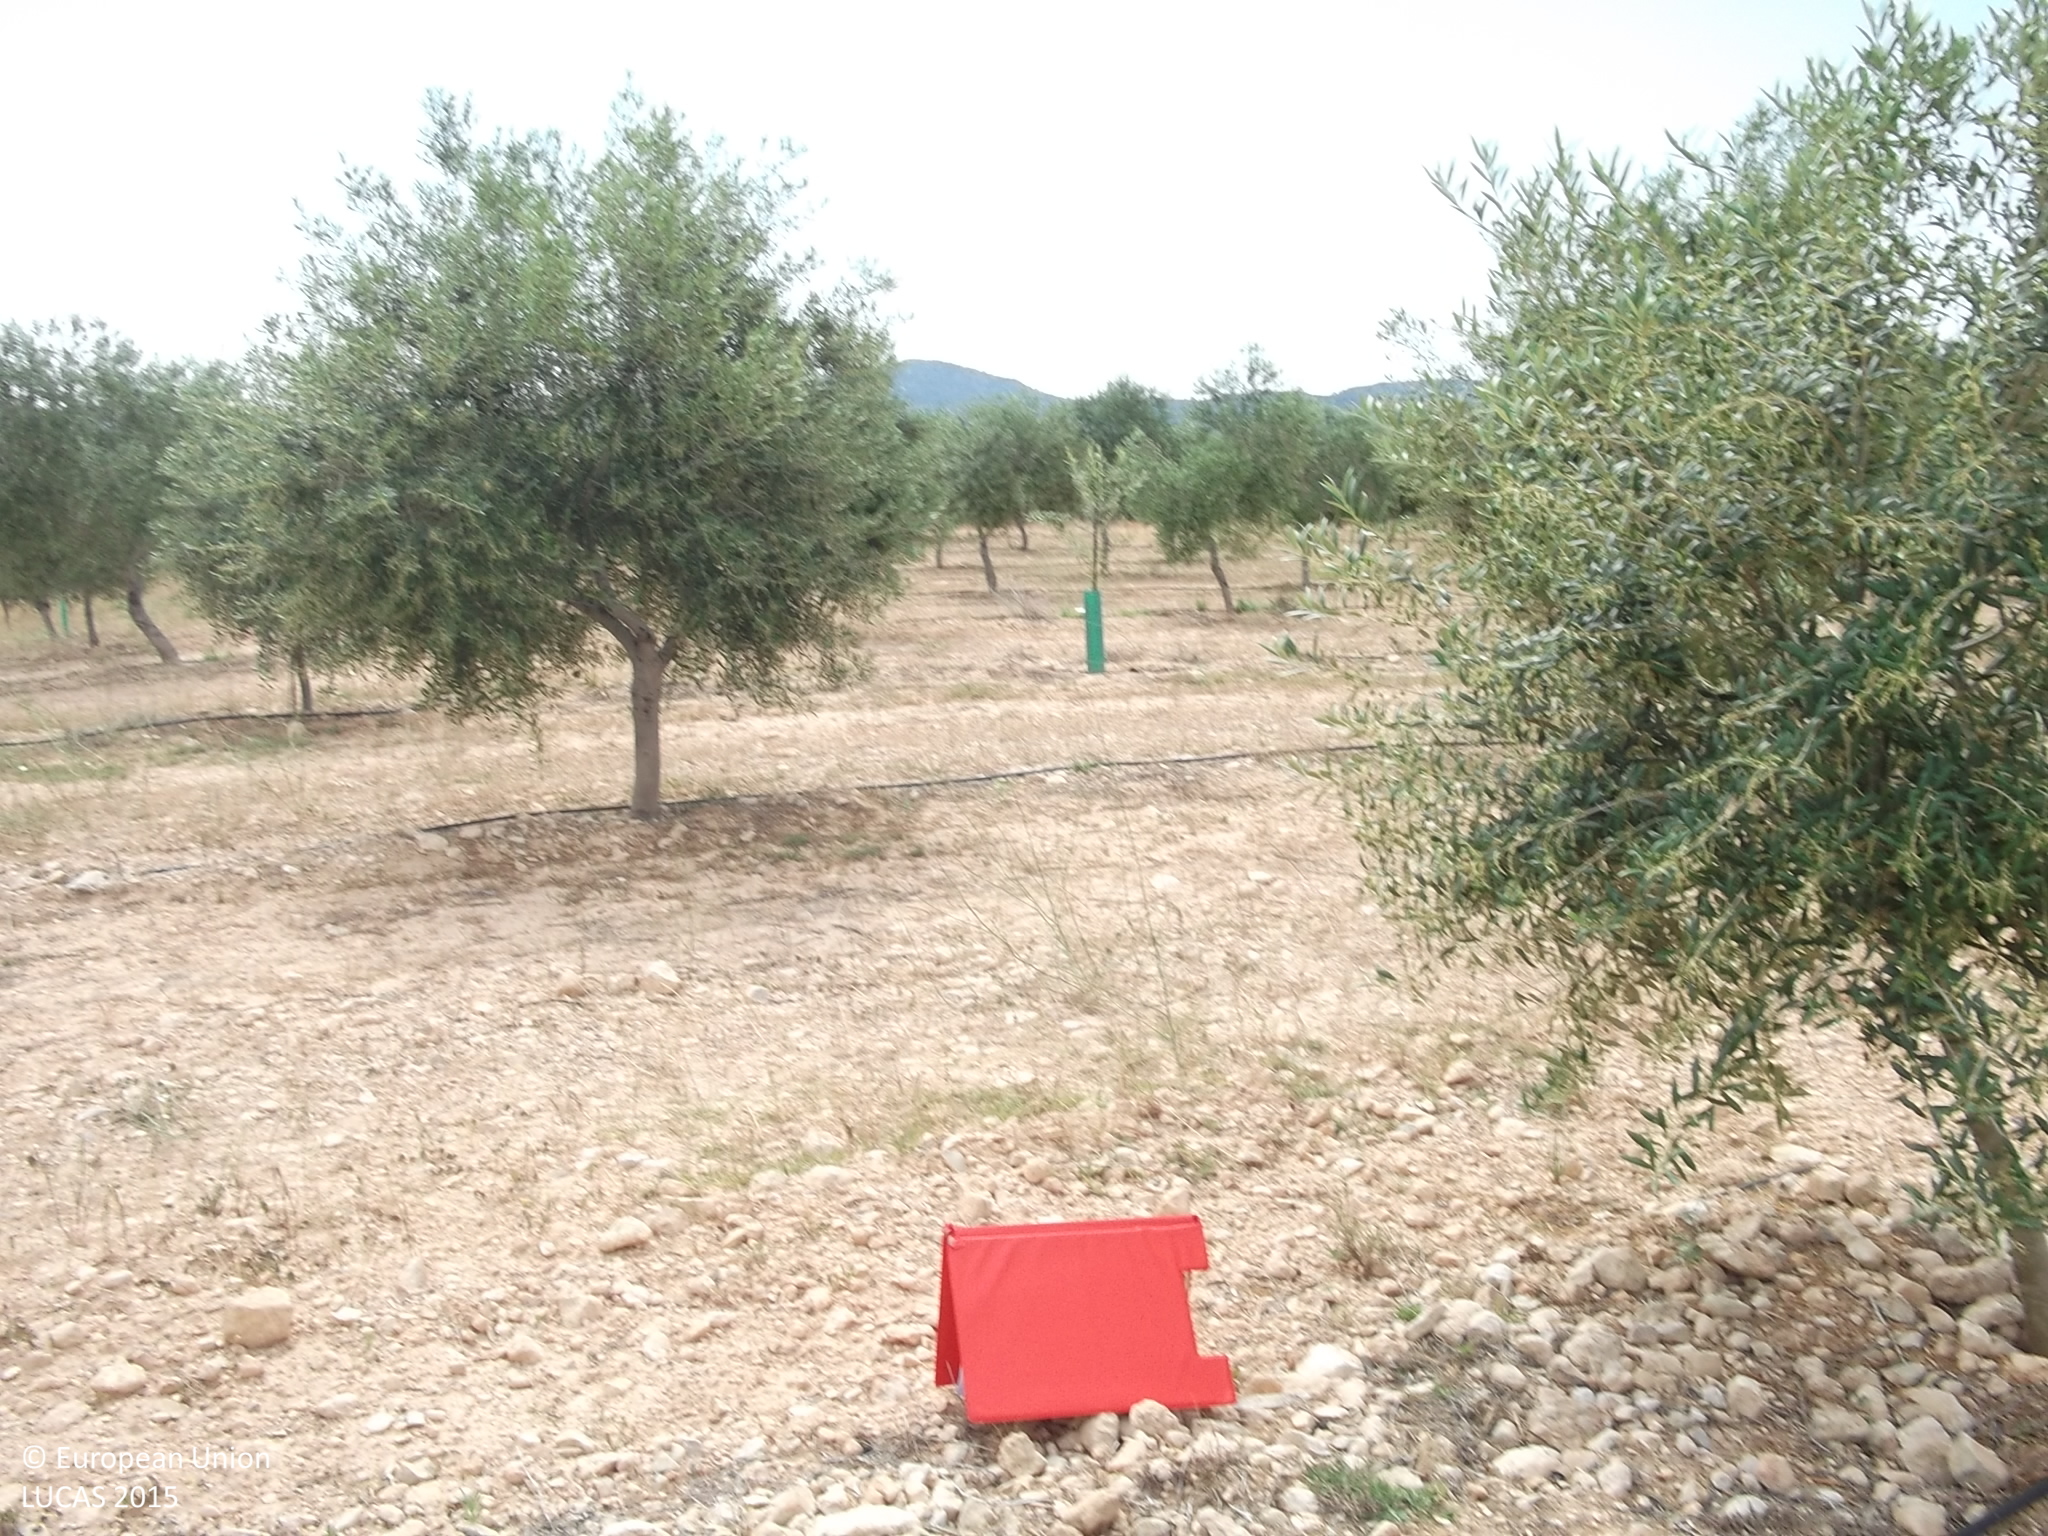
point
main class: Cropland
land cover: Olive groves
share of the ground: 10 - 25 %
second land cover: Spontaneously vegetated surfaces
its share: 50 - 75 %
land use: Agriculture (excluding fallow land and kitchen gardens)
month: June
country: ES
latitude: 38.4620
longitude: -1.6015
